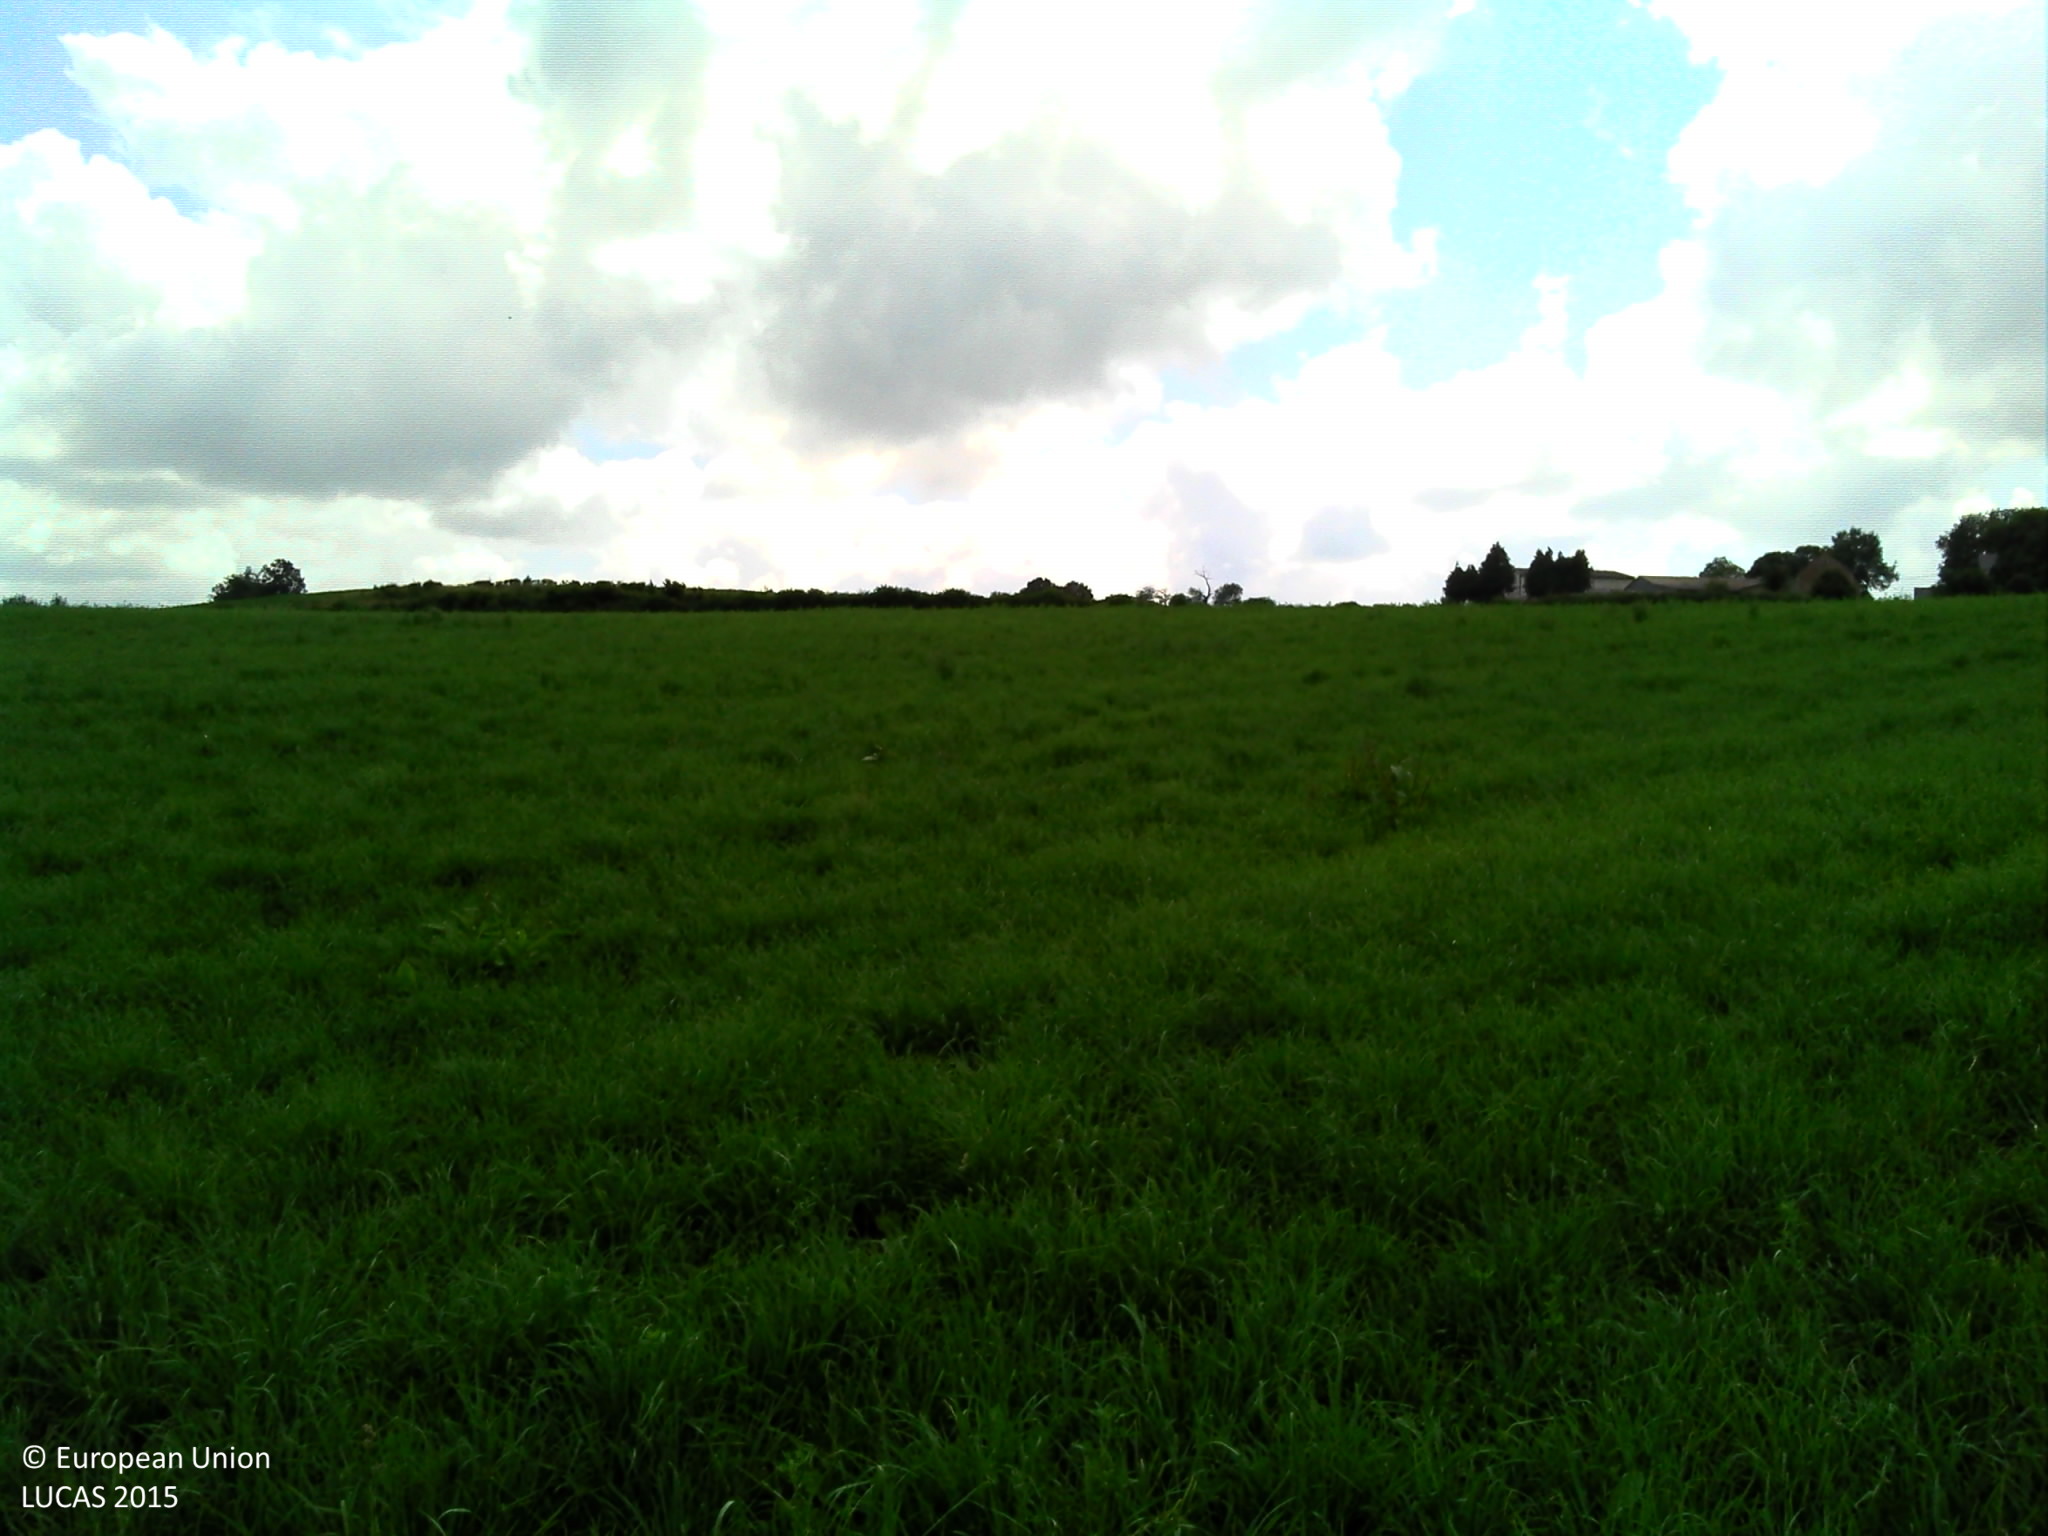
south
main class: Cropland
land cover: Temporary grasslands
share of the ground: > 75 %
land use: Agriculture (excluding fallow land and kitchen gardens)
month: June
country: FR
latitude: 44.3013
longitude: 2.5706
